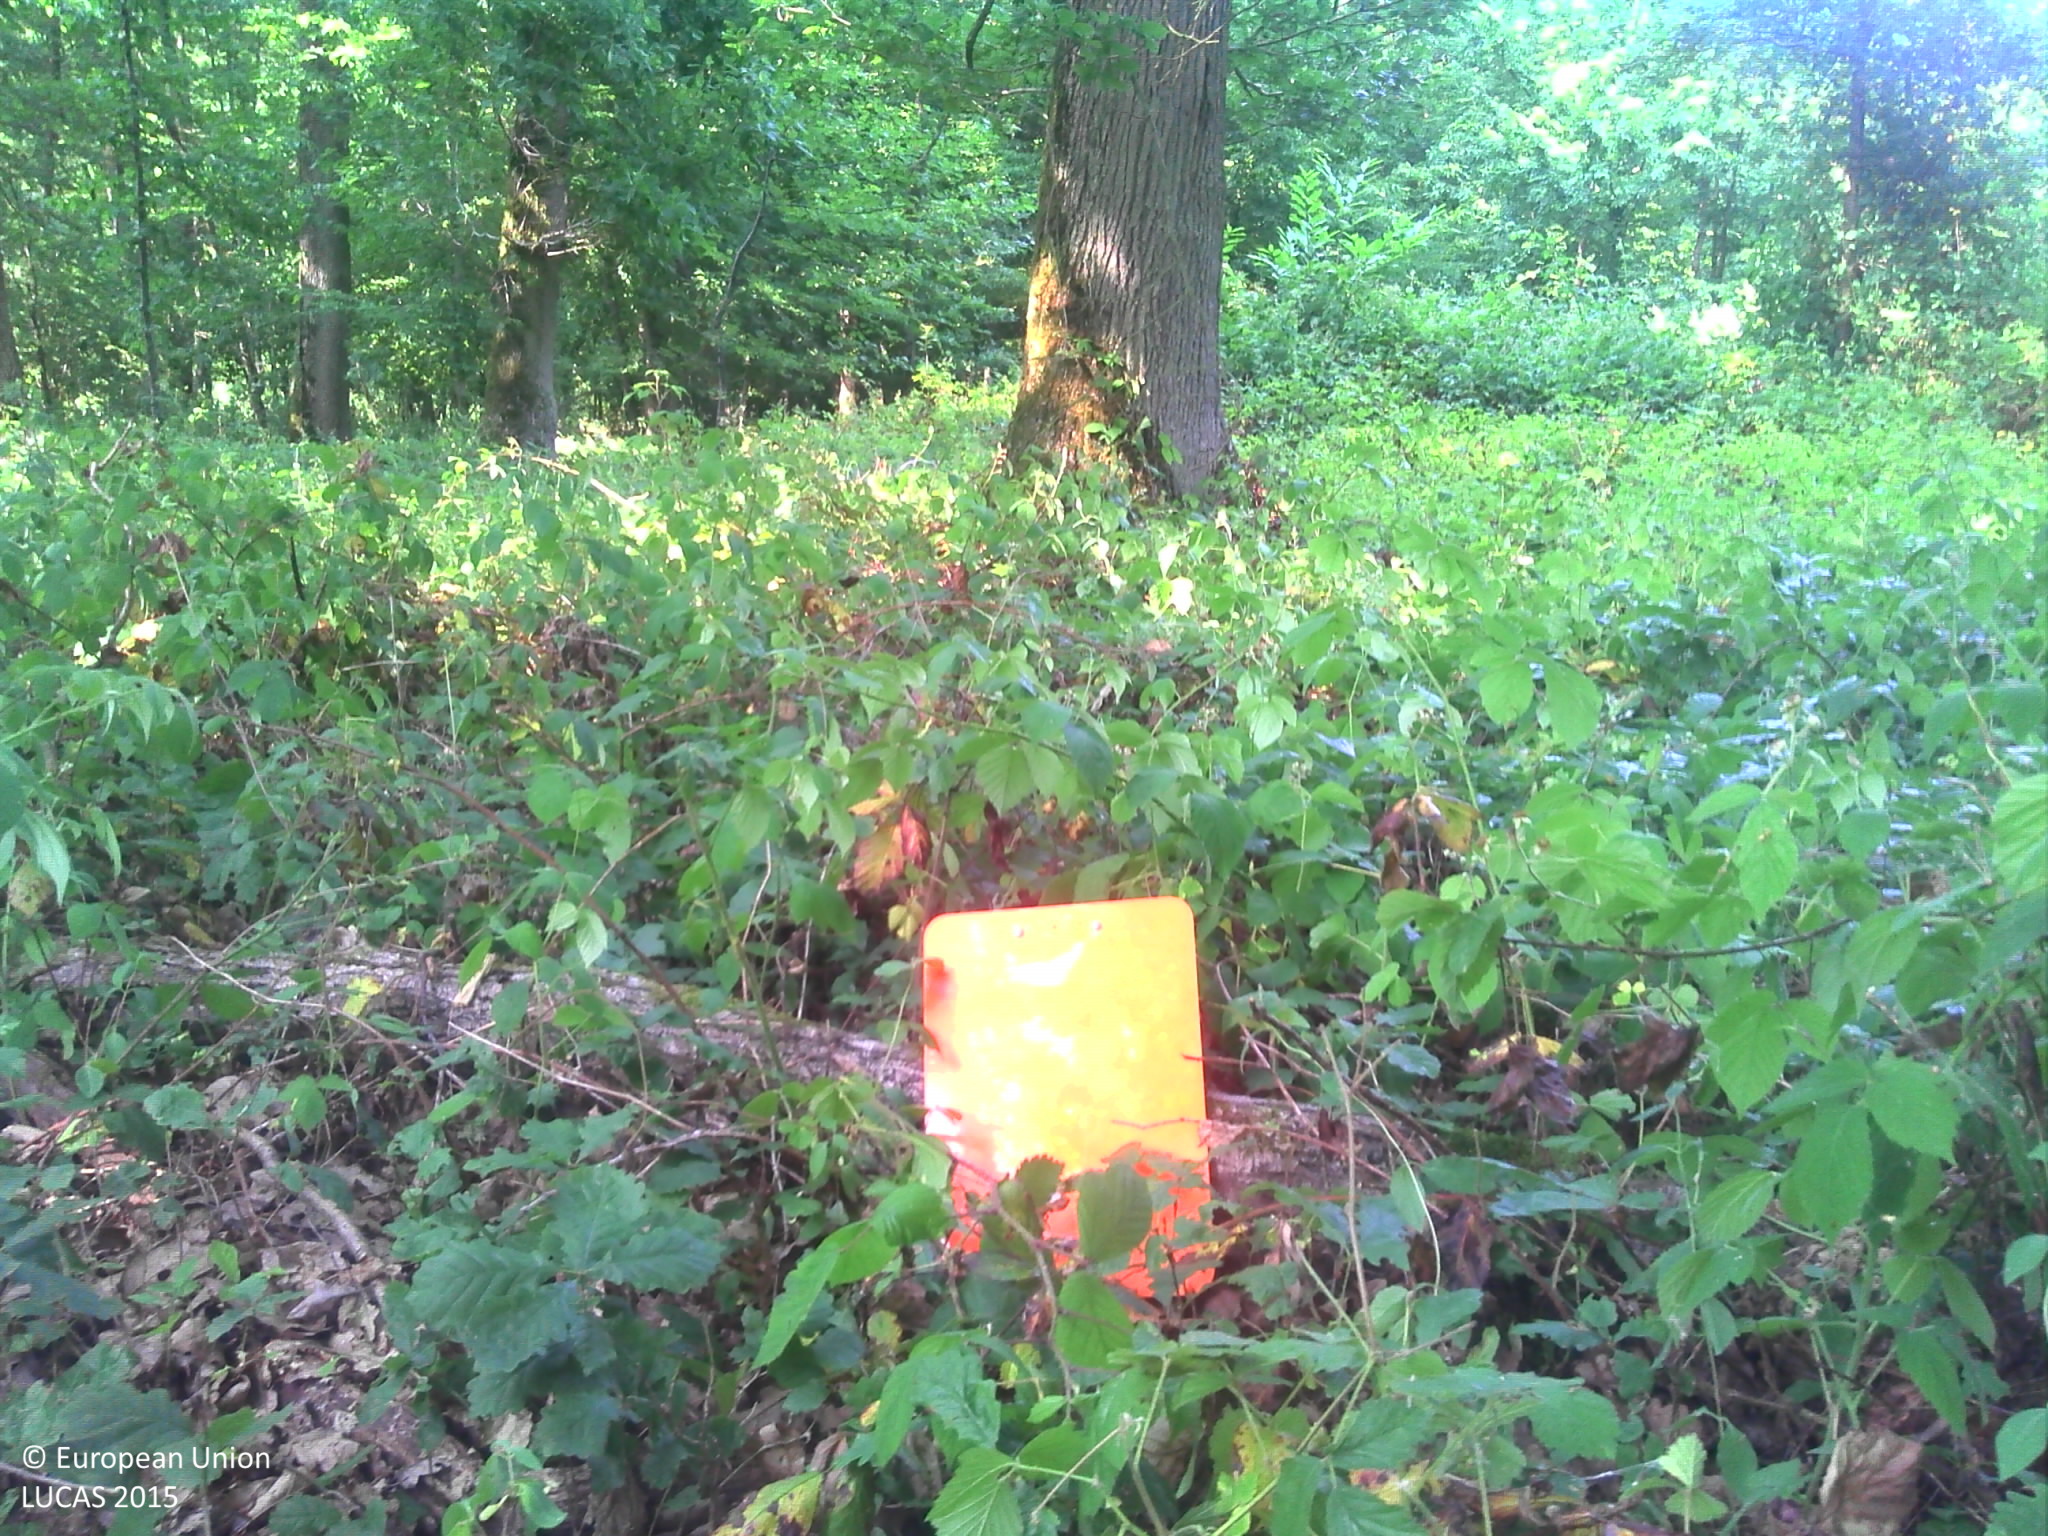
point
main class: Woodland
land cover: Broadleaved woodland
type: acidophilous oak and oak-birch forest
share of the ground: > 75 %
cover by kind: broadleaved forest trees 60 %, herbaceous plants 30 %, lichens and mosses 10 %
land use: Forestry
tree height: > 5 m
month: July
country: FR
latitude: 48.7227
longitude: 1.2128
